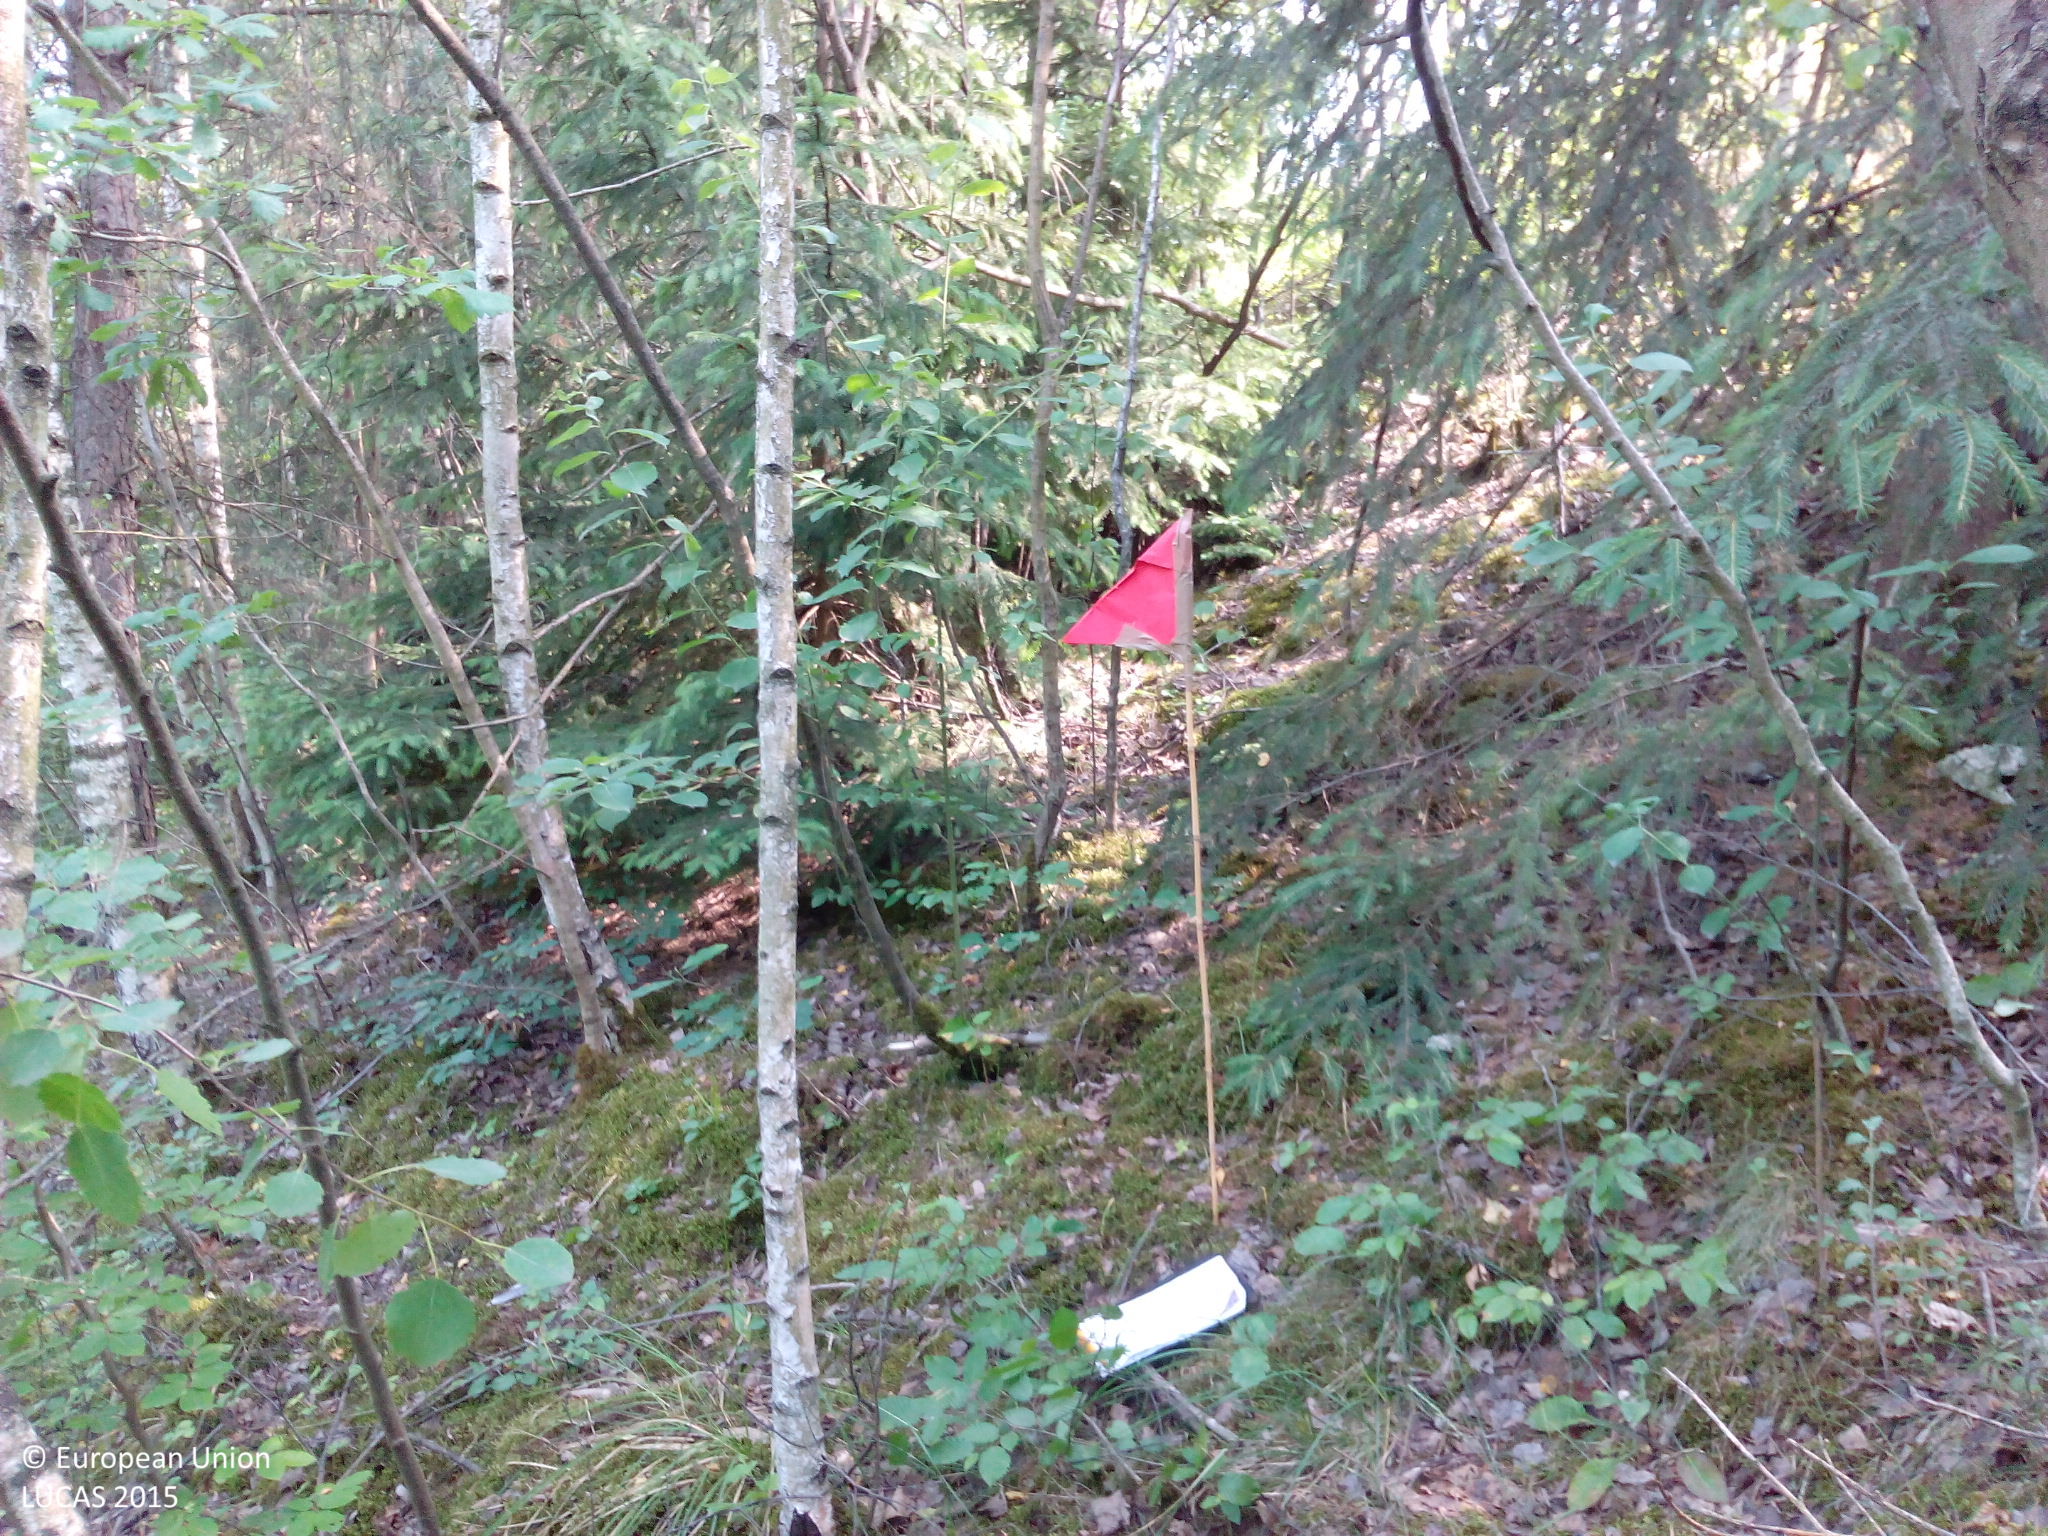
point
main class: Woodland
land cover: Other mixed woodland
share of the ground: > 75 %
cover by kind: coniferous forest trees 75 %, broadleaved forest trees 25 %
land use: Semi-natural and natural areas not in use
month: July
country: DE
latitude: 49.3389
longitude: 7.1515
